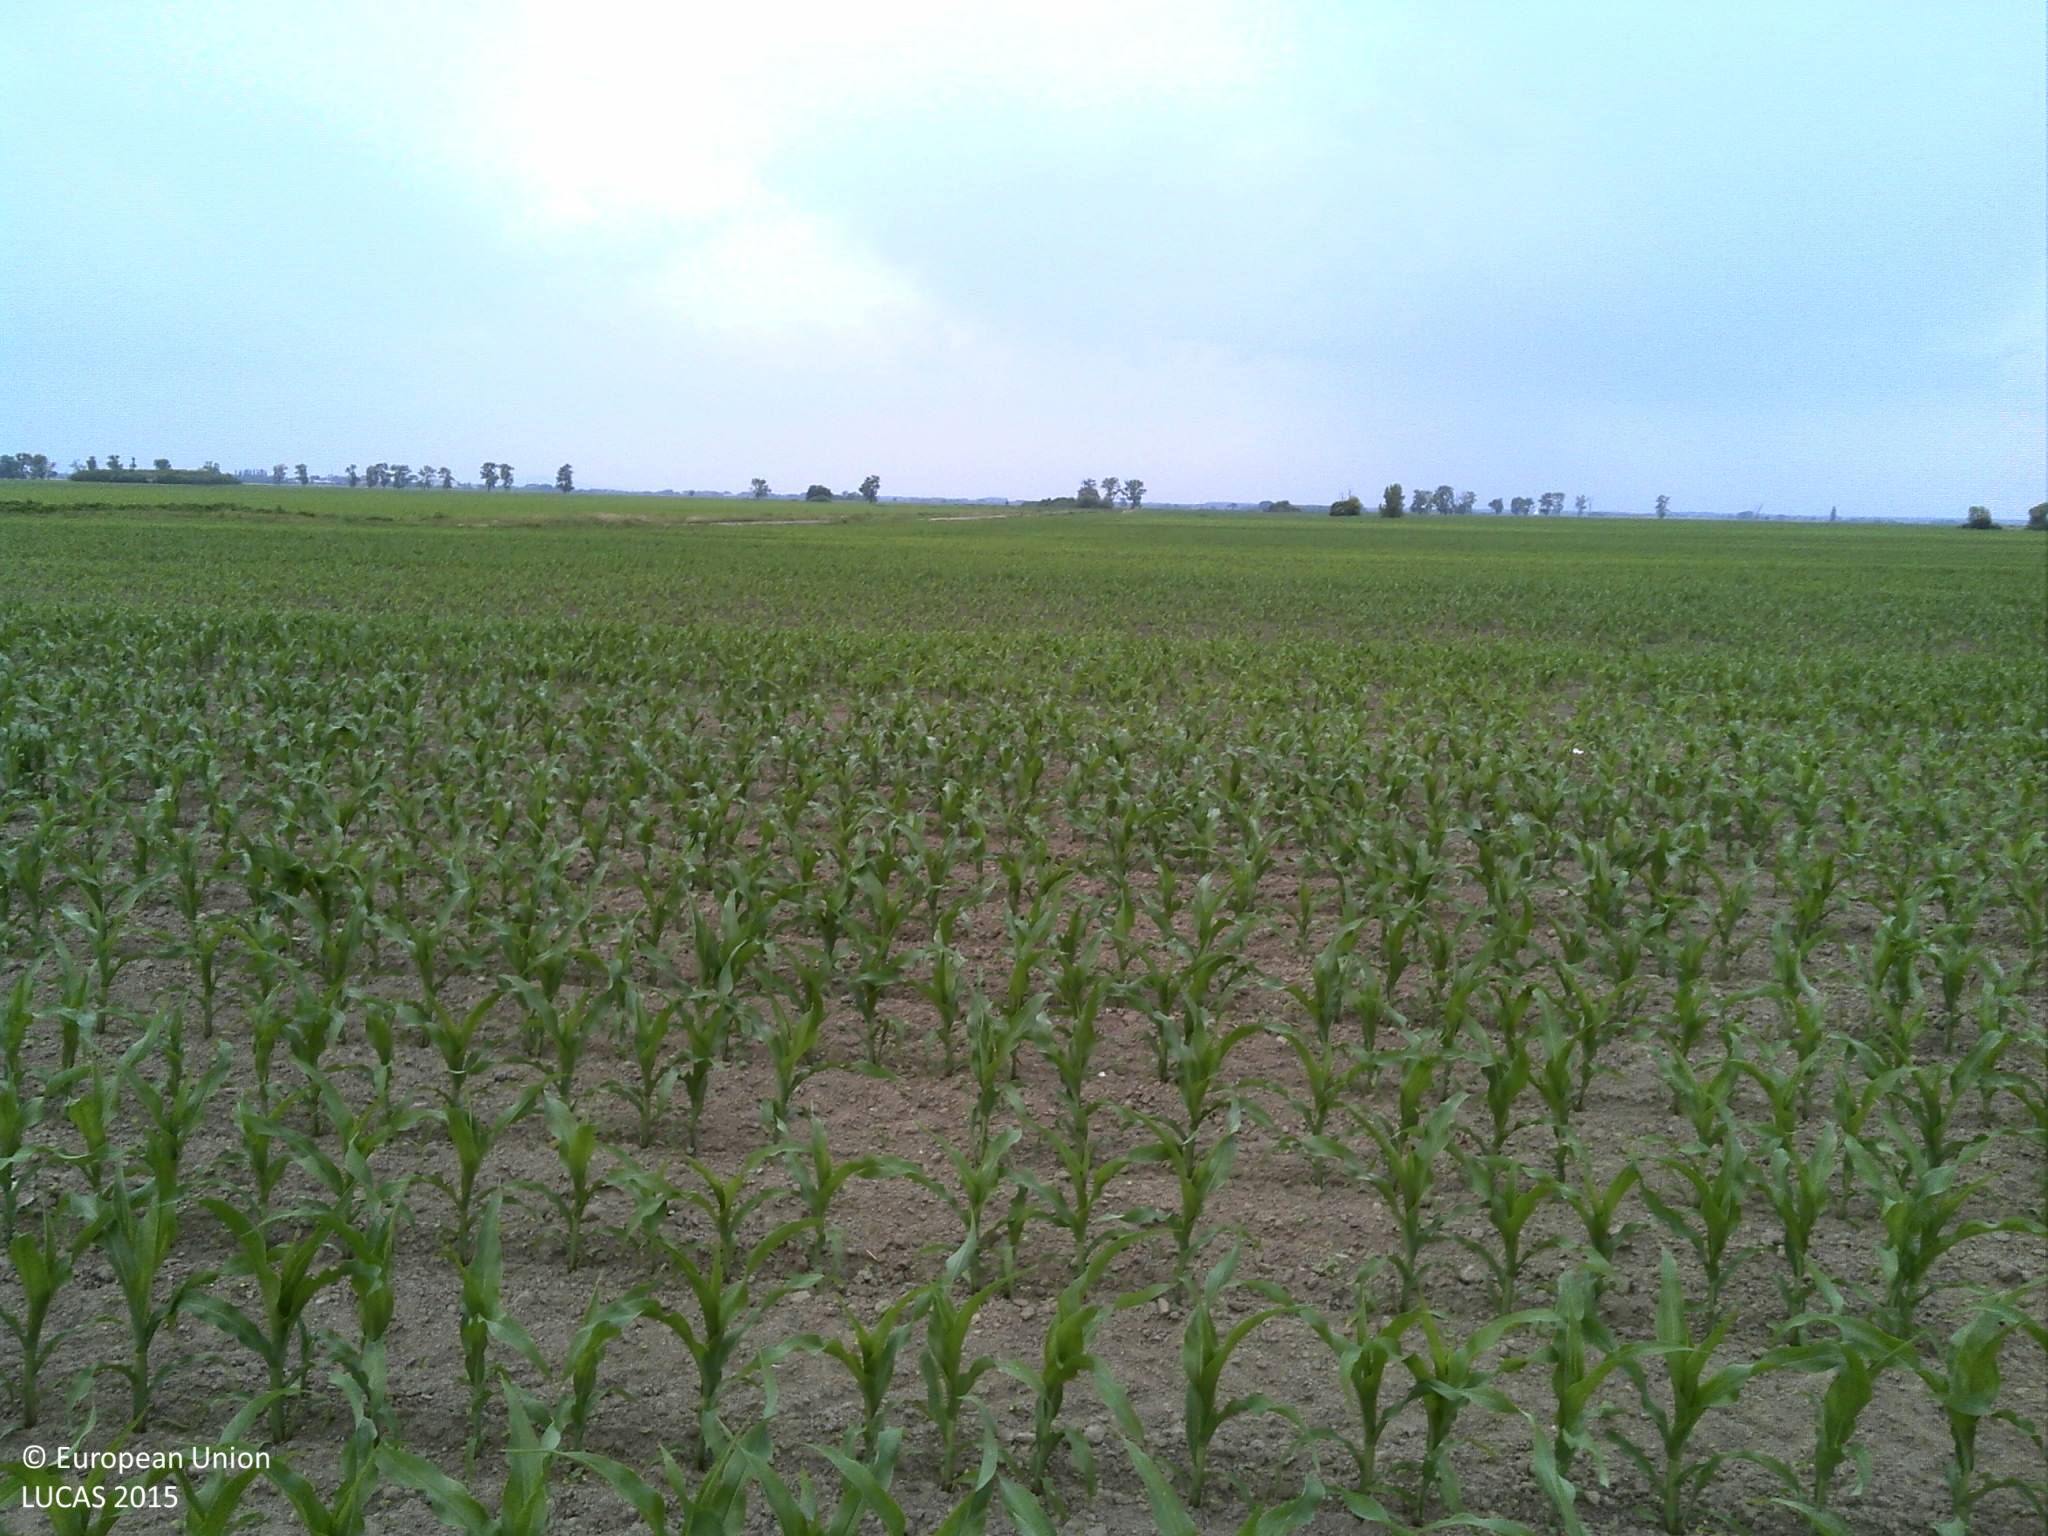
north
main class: Cropland
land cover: Maize
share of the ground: 25 - 50 %
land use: Agriculture (excluding fallow land and kitchen gardens)
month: May
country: HR
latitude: 45.5438
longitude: 18.4722
